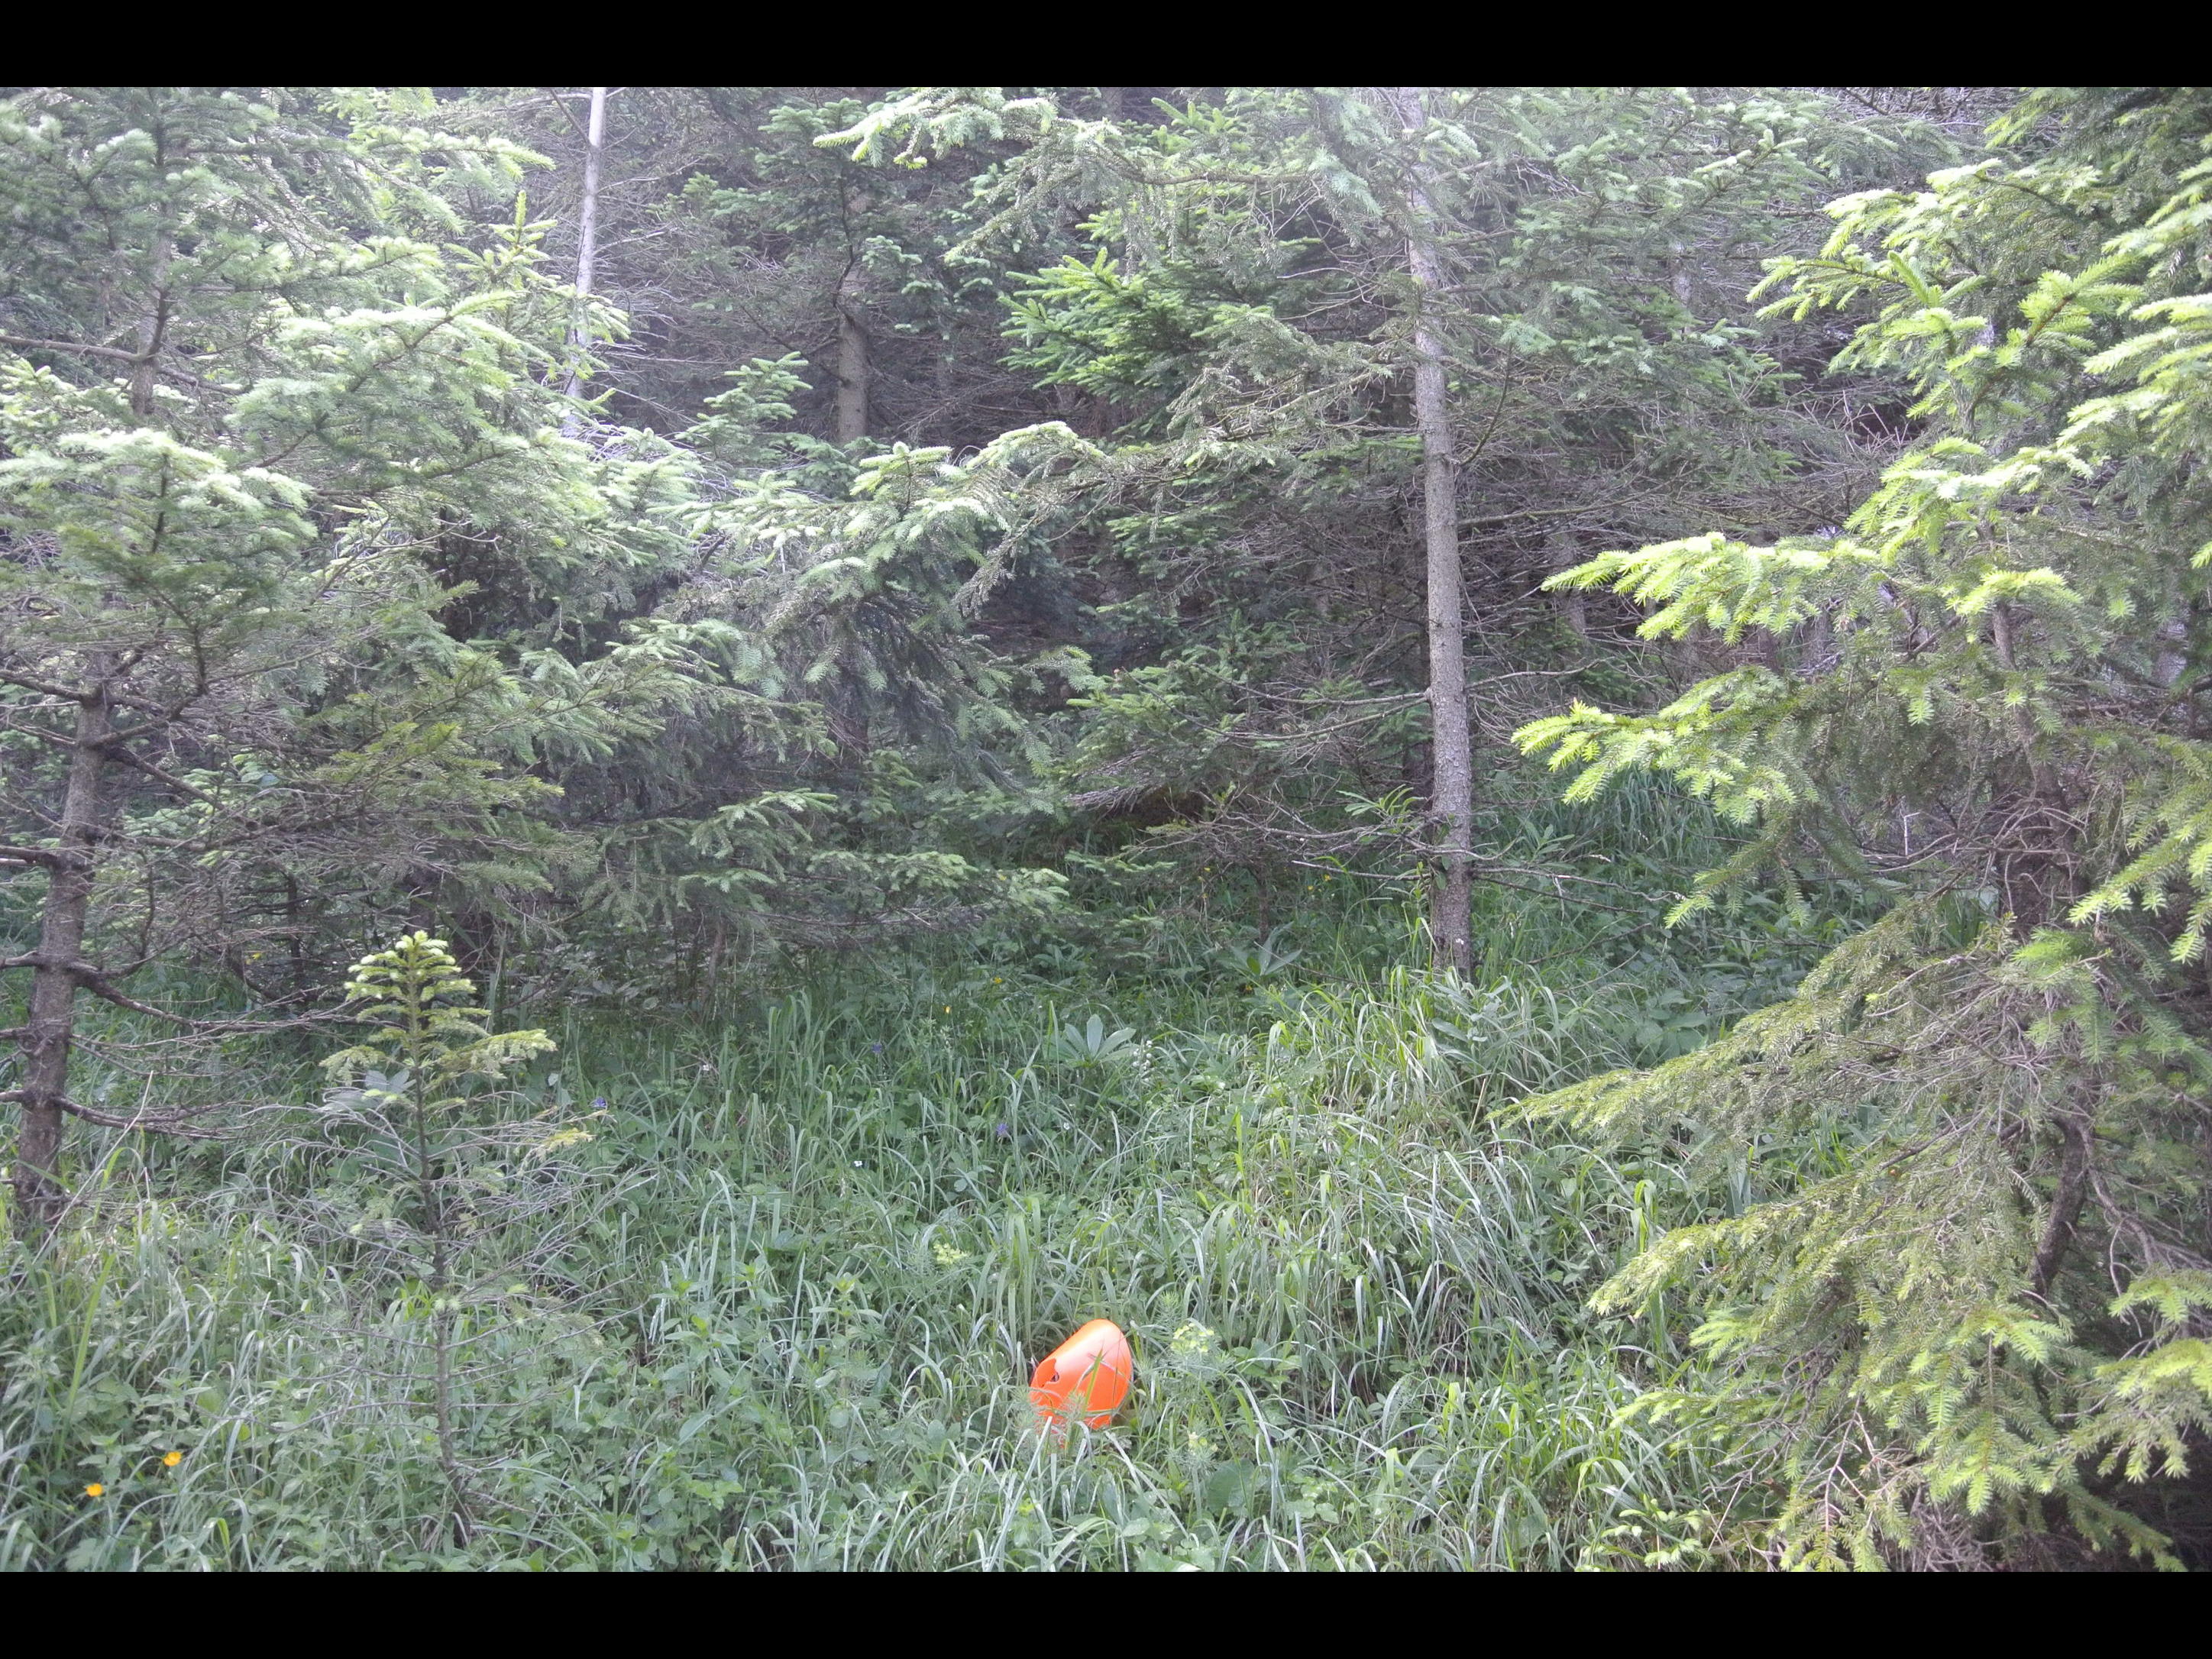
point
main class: Woodland
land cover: Spruce dominated coniferous woodland
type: alpine coniferous forest
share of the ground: > 75 %
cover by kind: coniferous forest trees 90 %, herbaceous plants 10 %
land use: Forestry
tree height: > 5 m
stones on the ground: > 50 %
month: June
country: AT
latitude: 47.8574
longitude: 15.3879
